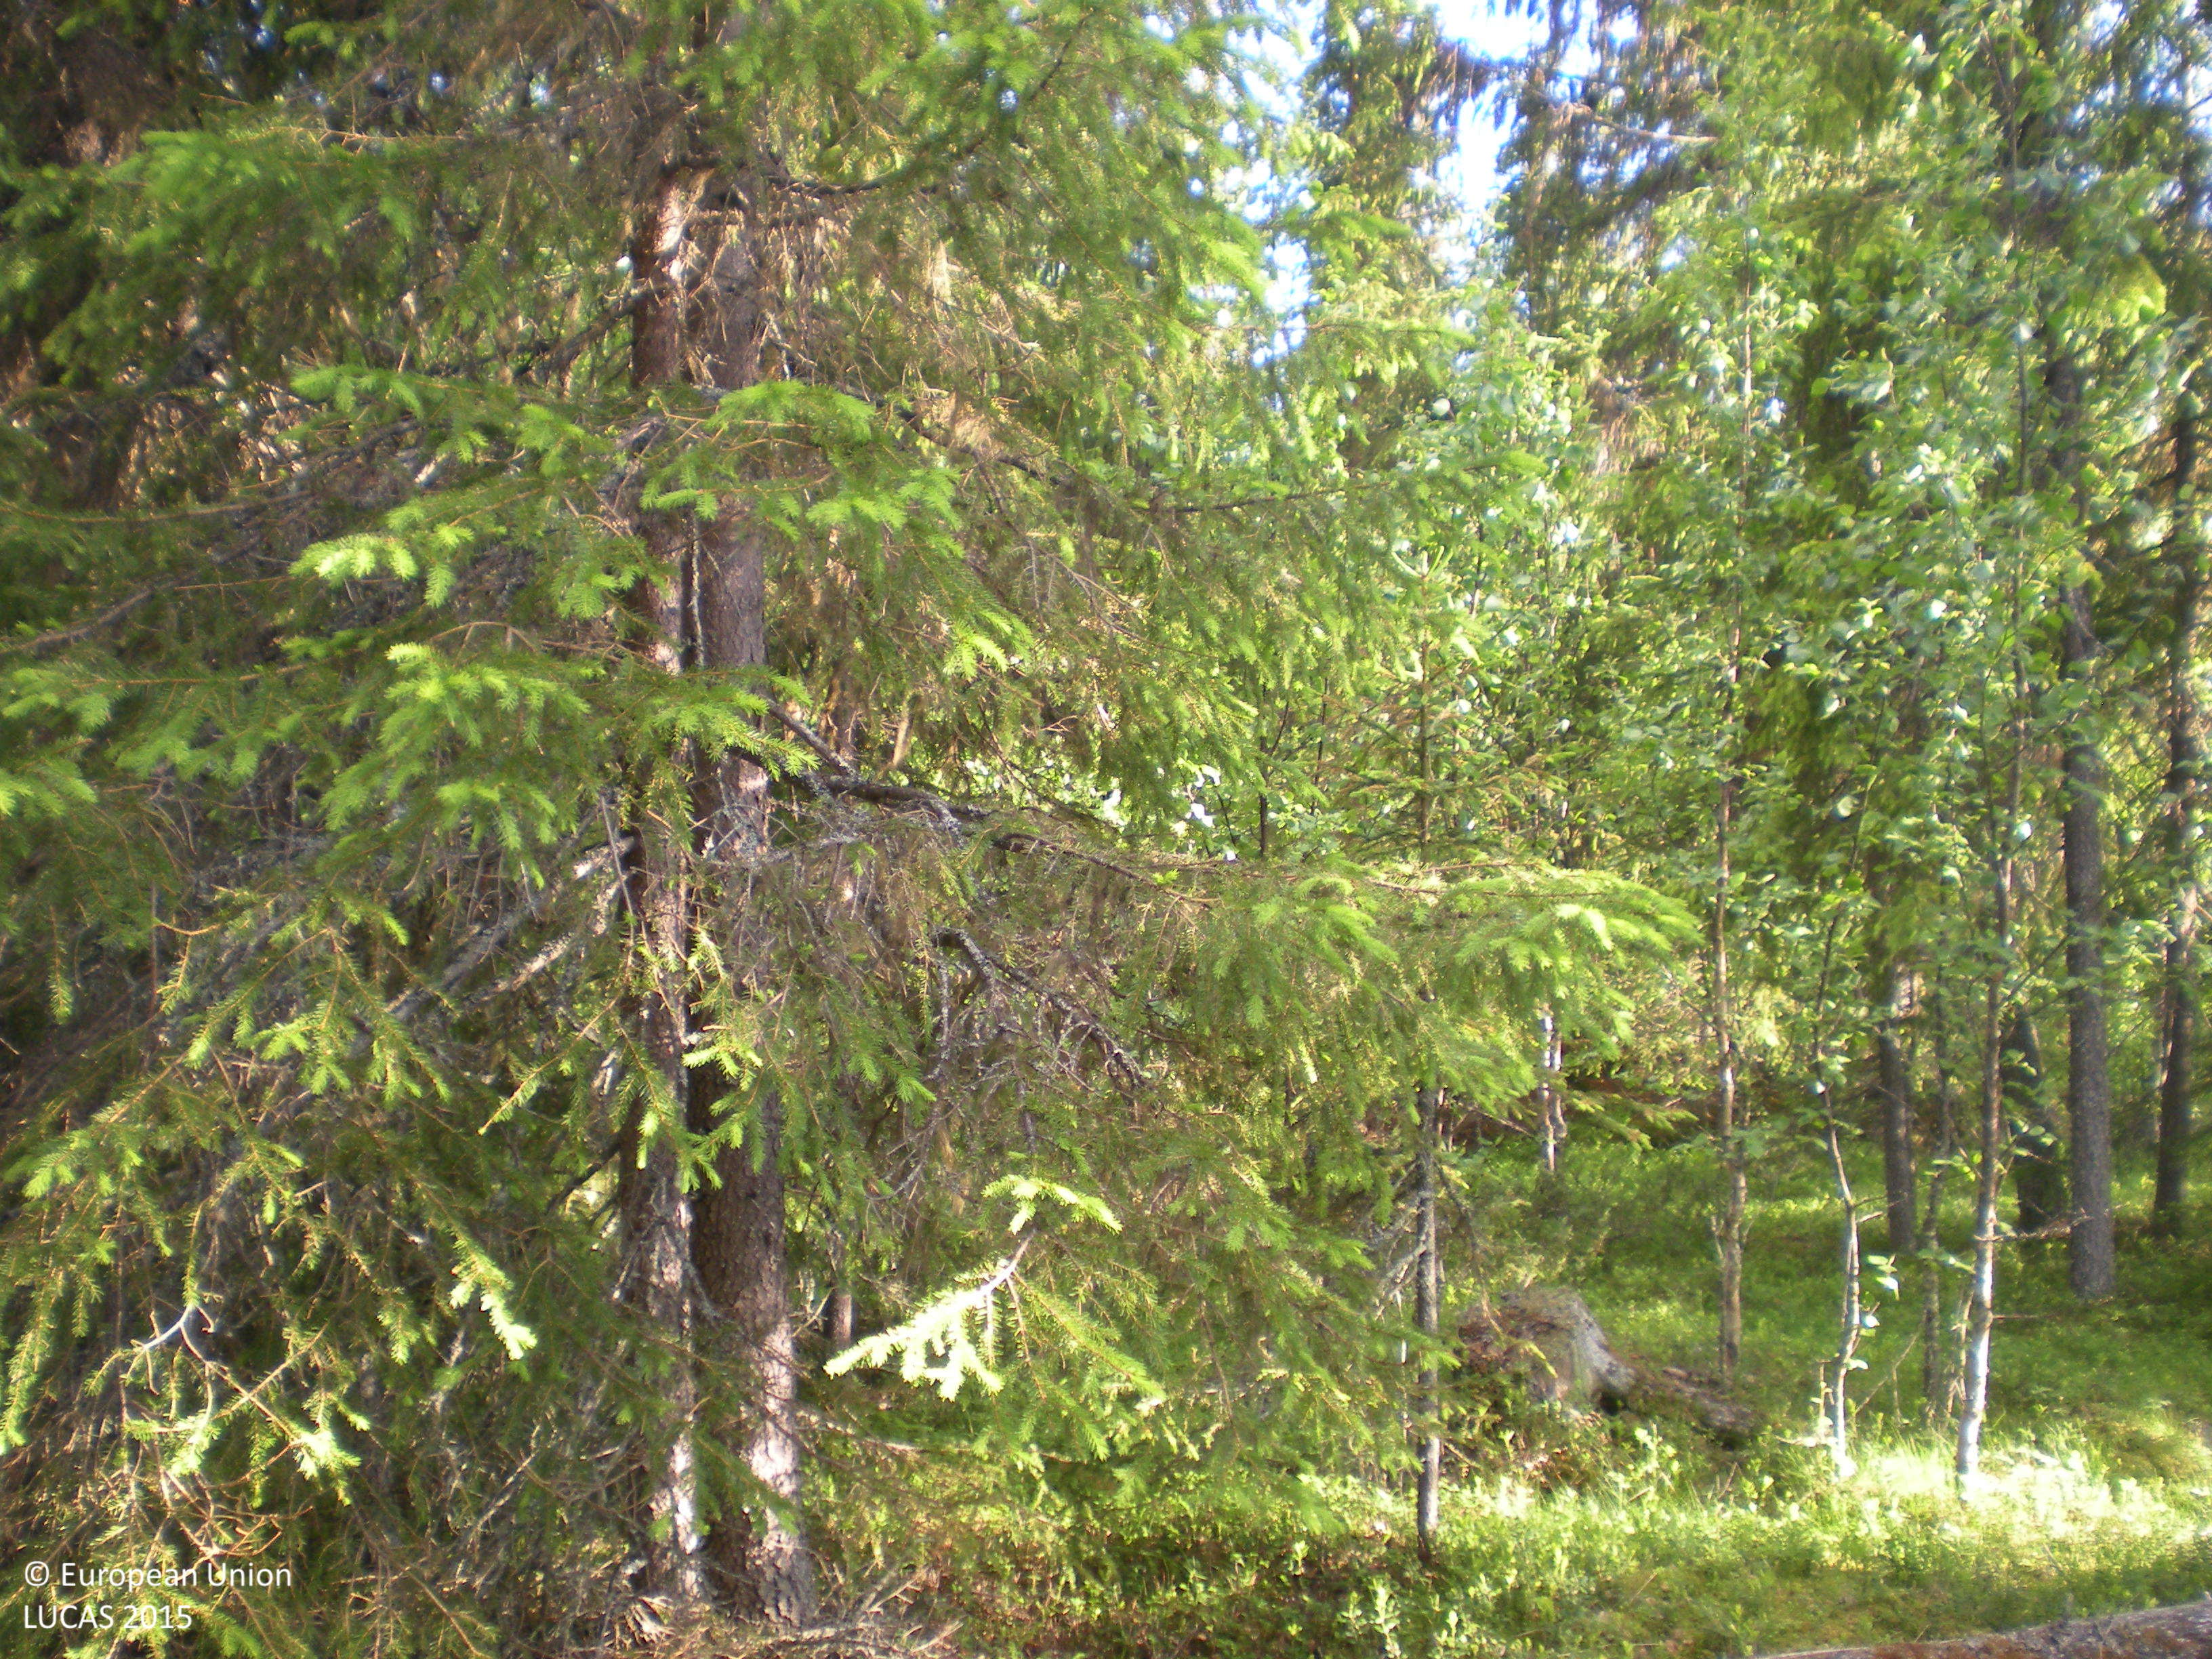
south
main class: Woodland
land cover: Spruce dominated mixed woodland
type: boreal forest
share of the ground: > 75 %
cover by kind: coniferous forest trees 60 %, broadleaved forest trees 20 %, shrubs 10 %, herbaceous plants 5 %, lichens and mosses 5 %
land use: Forestry
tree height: > 5 m
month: July
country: SE
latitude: 65.6025
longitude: 17.0543
